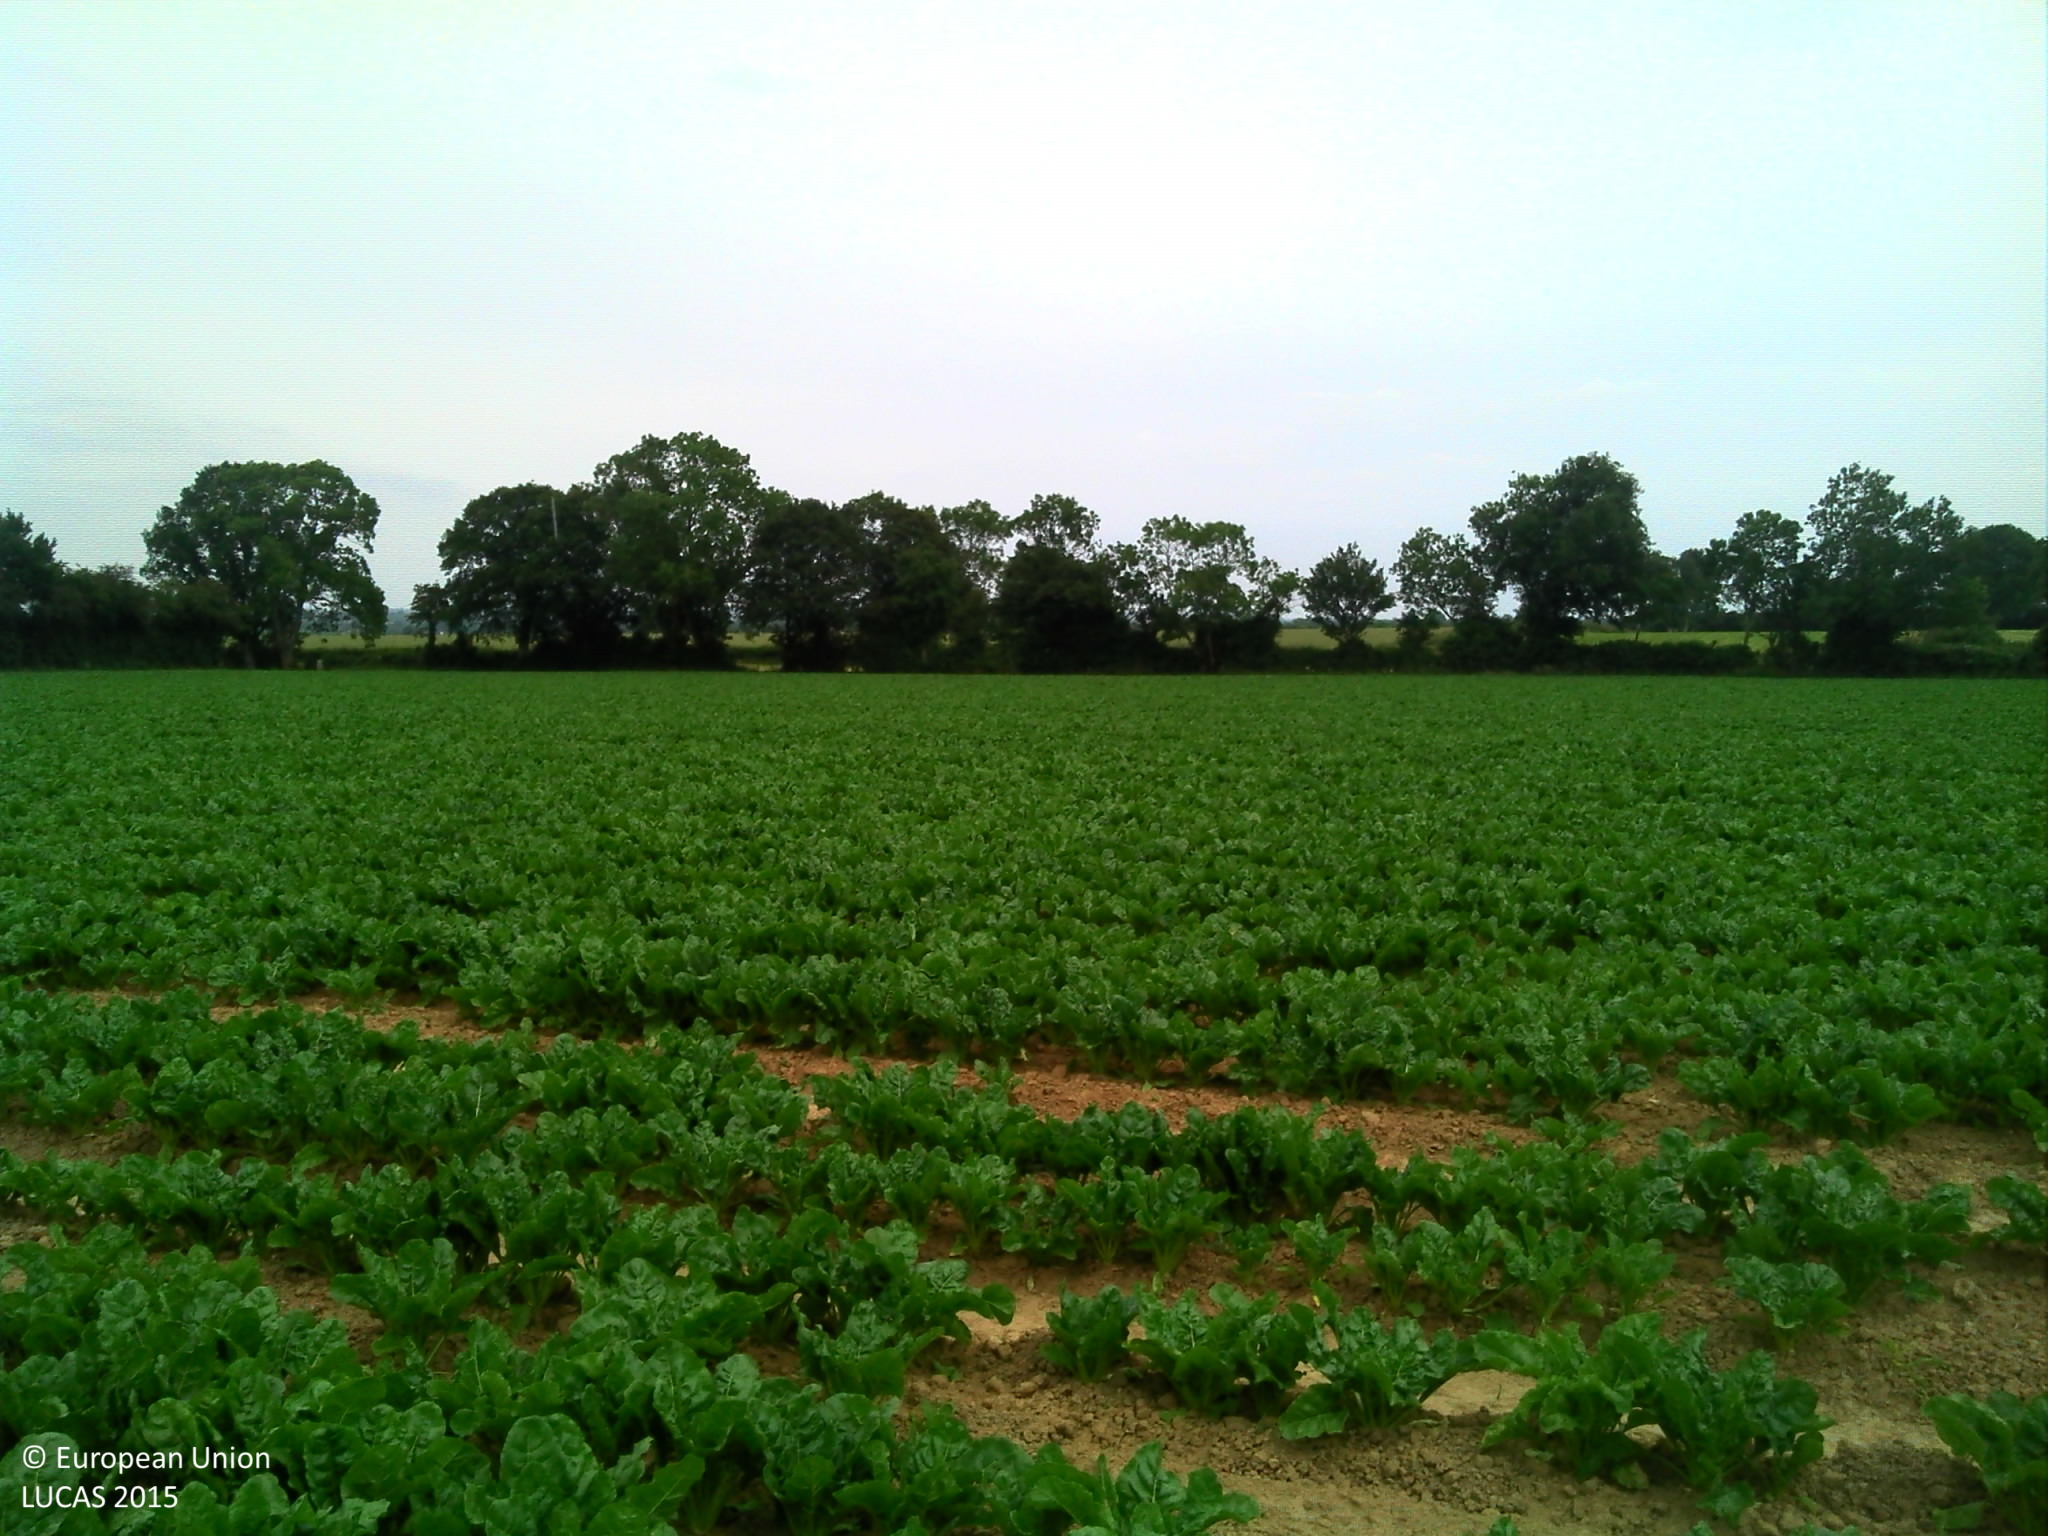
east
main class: Cropland
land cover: Sugar beet
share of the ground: > 75 %
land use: Agriculture (excluding fallow land and kitchen gardens)
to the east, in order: Sugar beet; Grass margins; Managed hedges; Grassland without tree/shrub cover; Ditches and canals; Grass margins; Tracks; Grass margins; Ditches and canals; Managed hedges; Common wheat
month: June
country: FR
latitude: 48.6366
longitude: 0.1878
